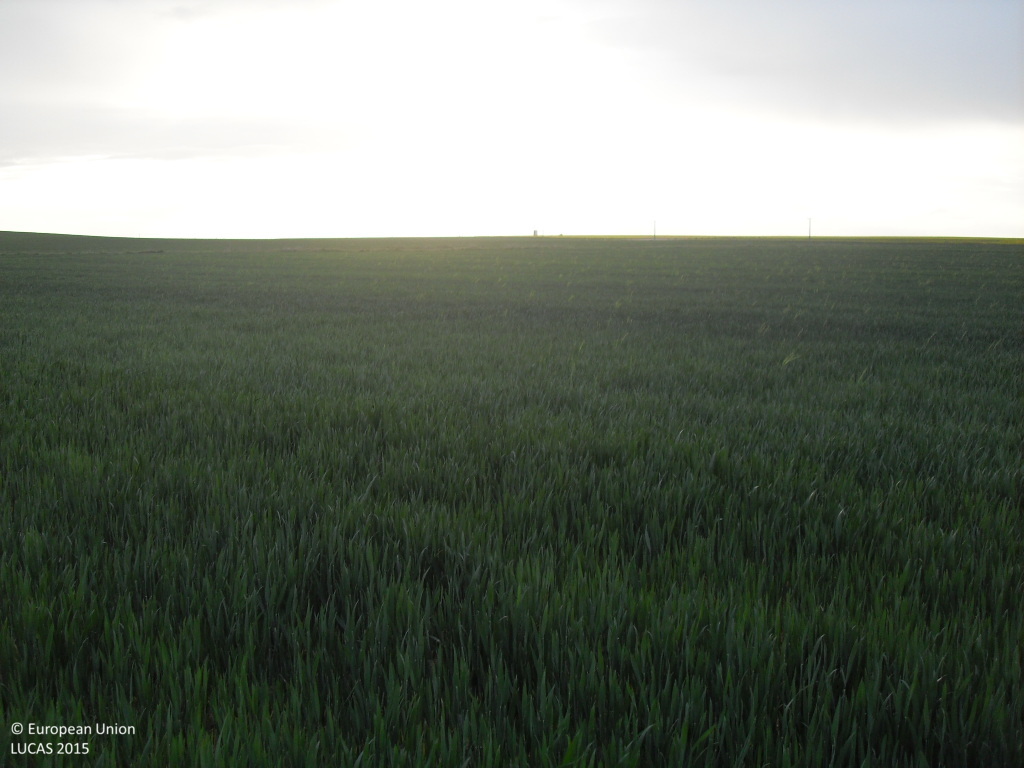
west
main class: Cropland
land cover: Common wheat
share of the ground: > 75 %
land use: Agriculture (excluding fallow land and kitchen gardens)
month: April
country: ES
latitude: 40.9994
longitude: -5.2271
